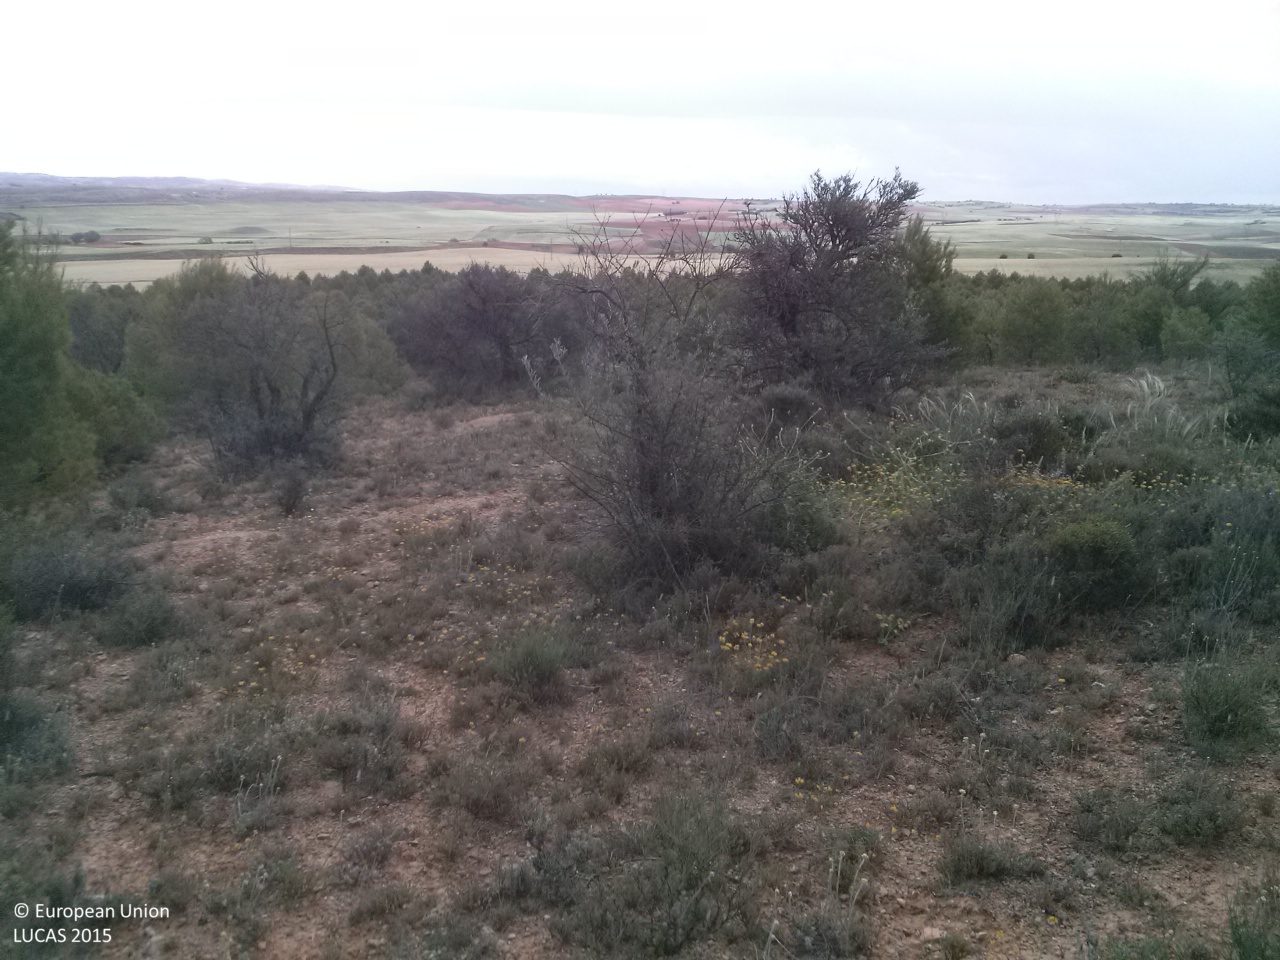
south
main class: Woodland
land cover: Pine dominated mixed woodland
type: coniferous forest of the mediterranean region
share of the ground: 10 - 25 %
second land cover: Shrubland without tree cover
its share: 50 - 75 %
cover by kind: shrubs 30 %, unconsolidated bare surface 25 %, herbaceous plants 20 %, coniferous forest trees 15 %, broadleaved forest trees 10 %
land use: Forestry
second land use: Agriculture (excluding fallow land and kitchen gardens)
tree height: > 5 m
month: May
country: ES
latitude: 39.9802
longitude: -2.8913
